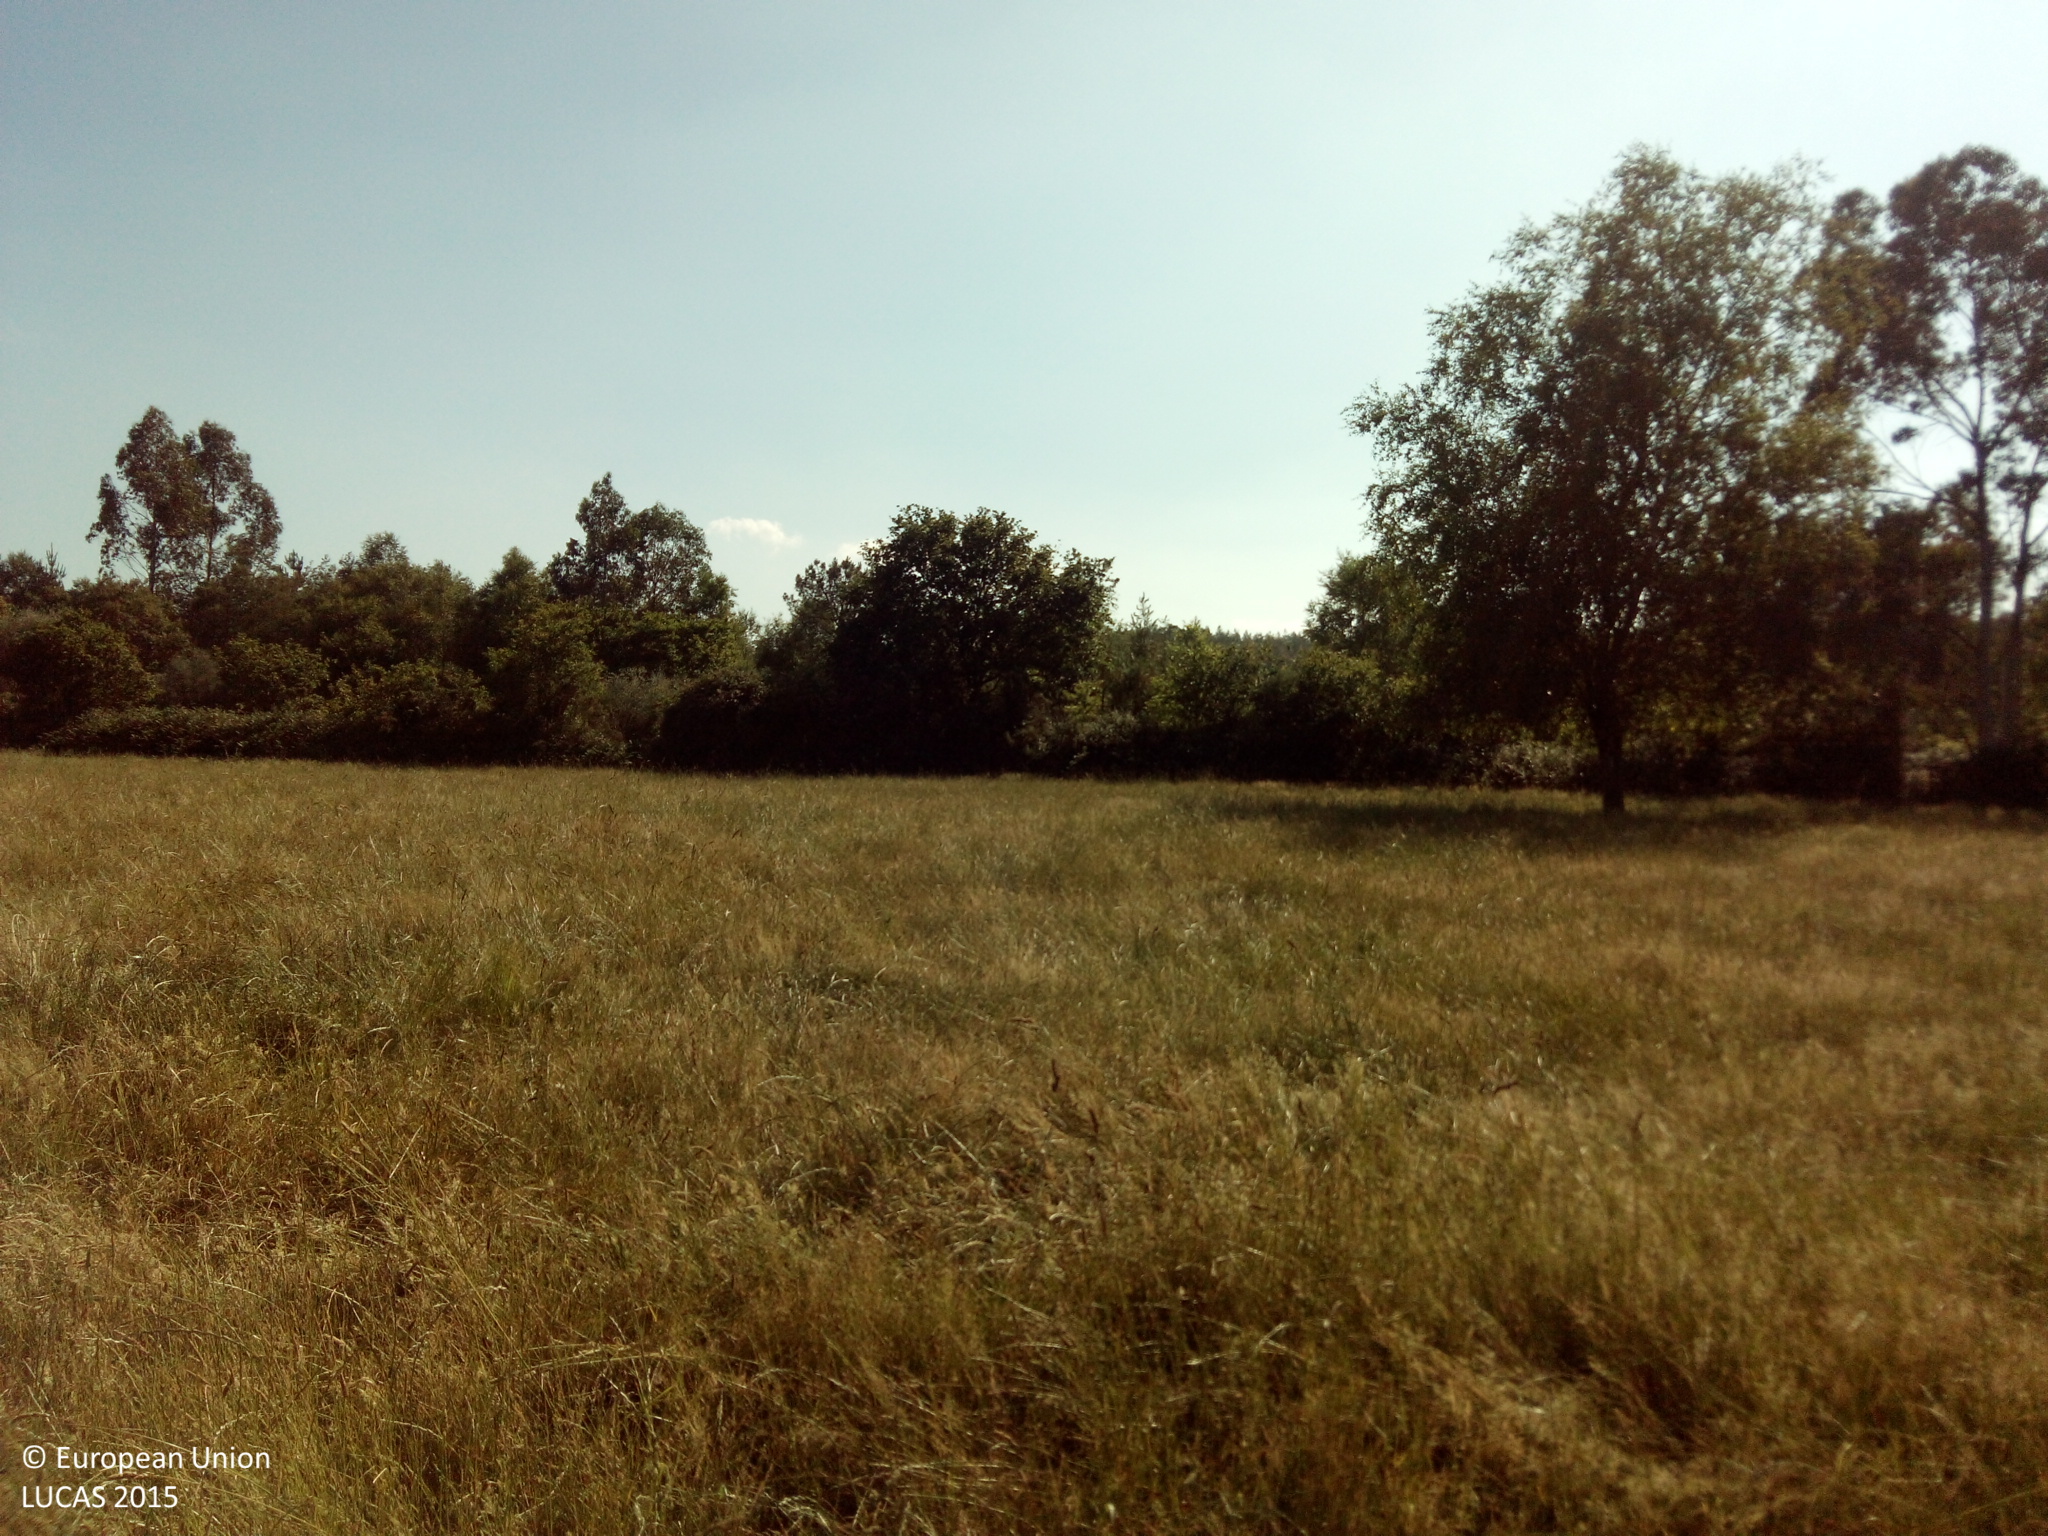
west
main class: Cropland
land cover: Mixed cereals for fodder
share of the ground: > 75 %
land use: Agriculture (excluding fallow land and kitchen gardens)
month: June
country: ES
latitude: 42.9722
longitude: -8.0537
